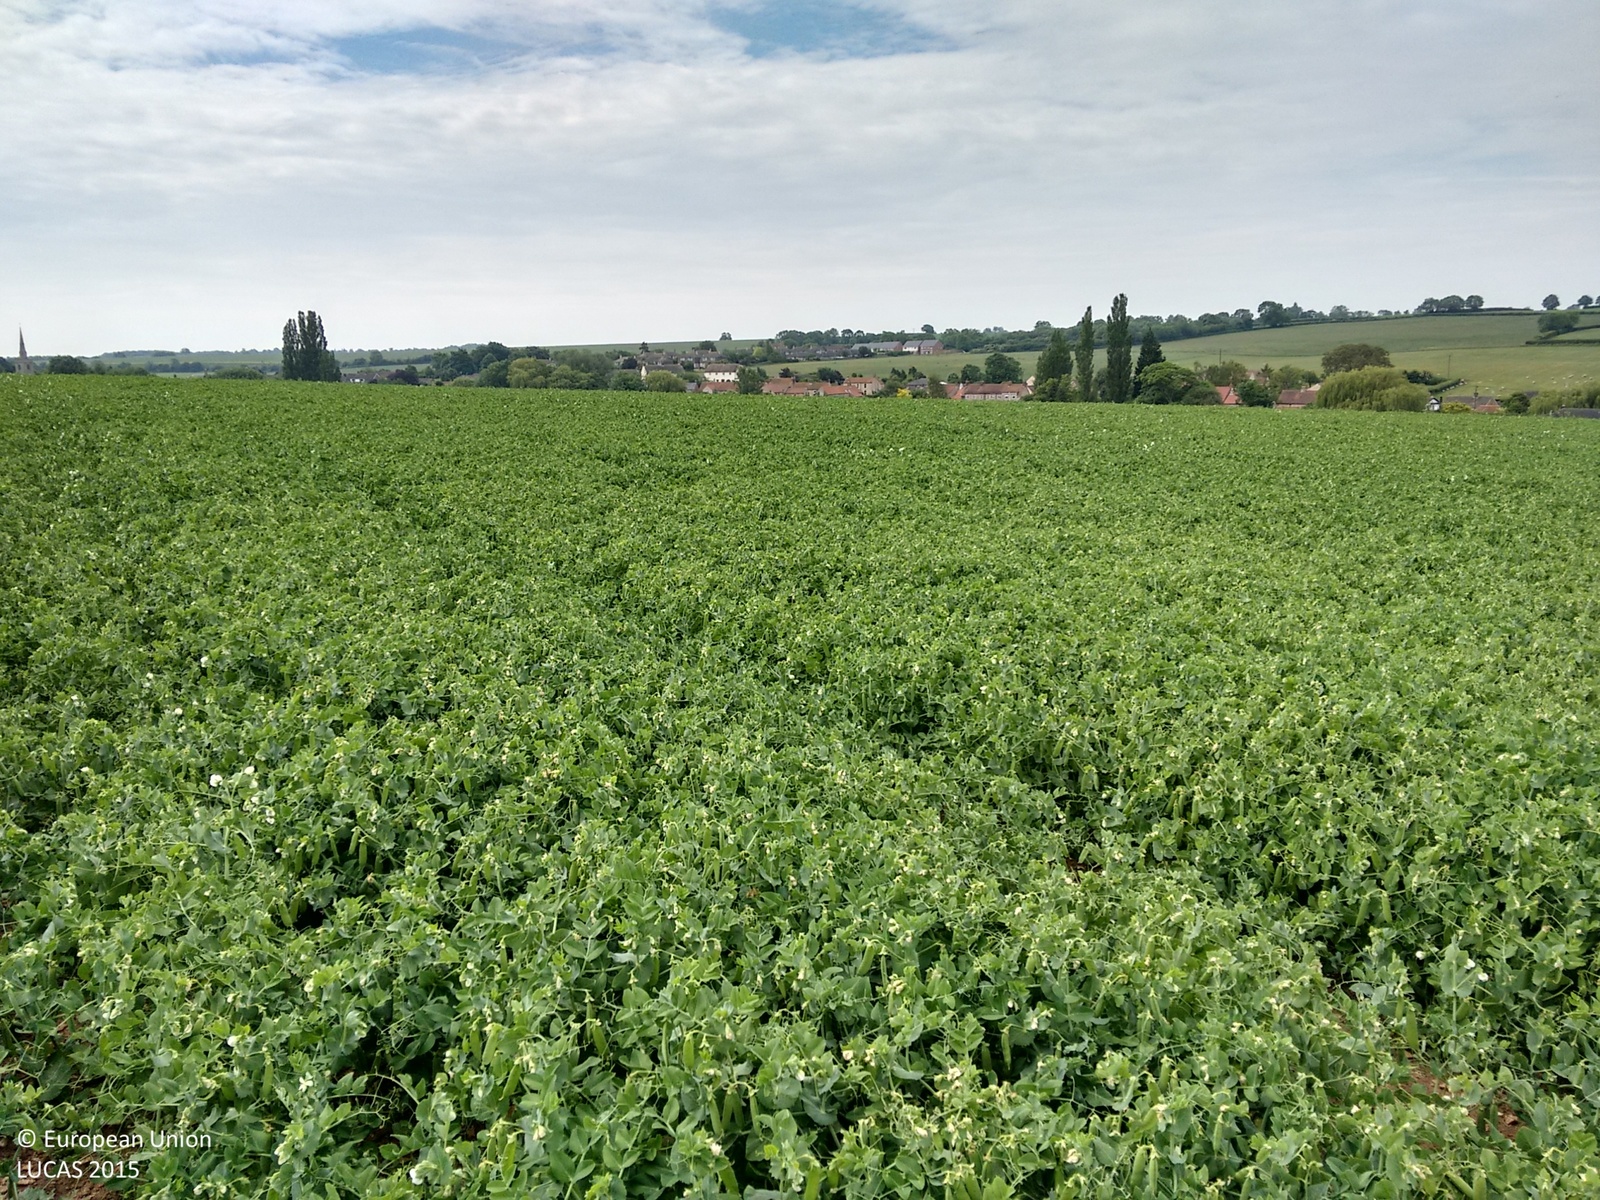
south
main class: Cropland
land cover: Dry pulses
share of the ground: > 75 %
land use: Agriculture (excluding fallow land and kitchen gardens)
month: June
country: GB
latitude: 52.9797
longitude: -0.5080
